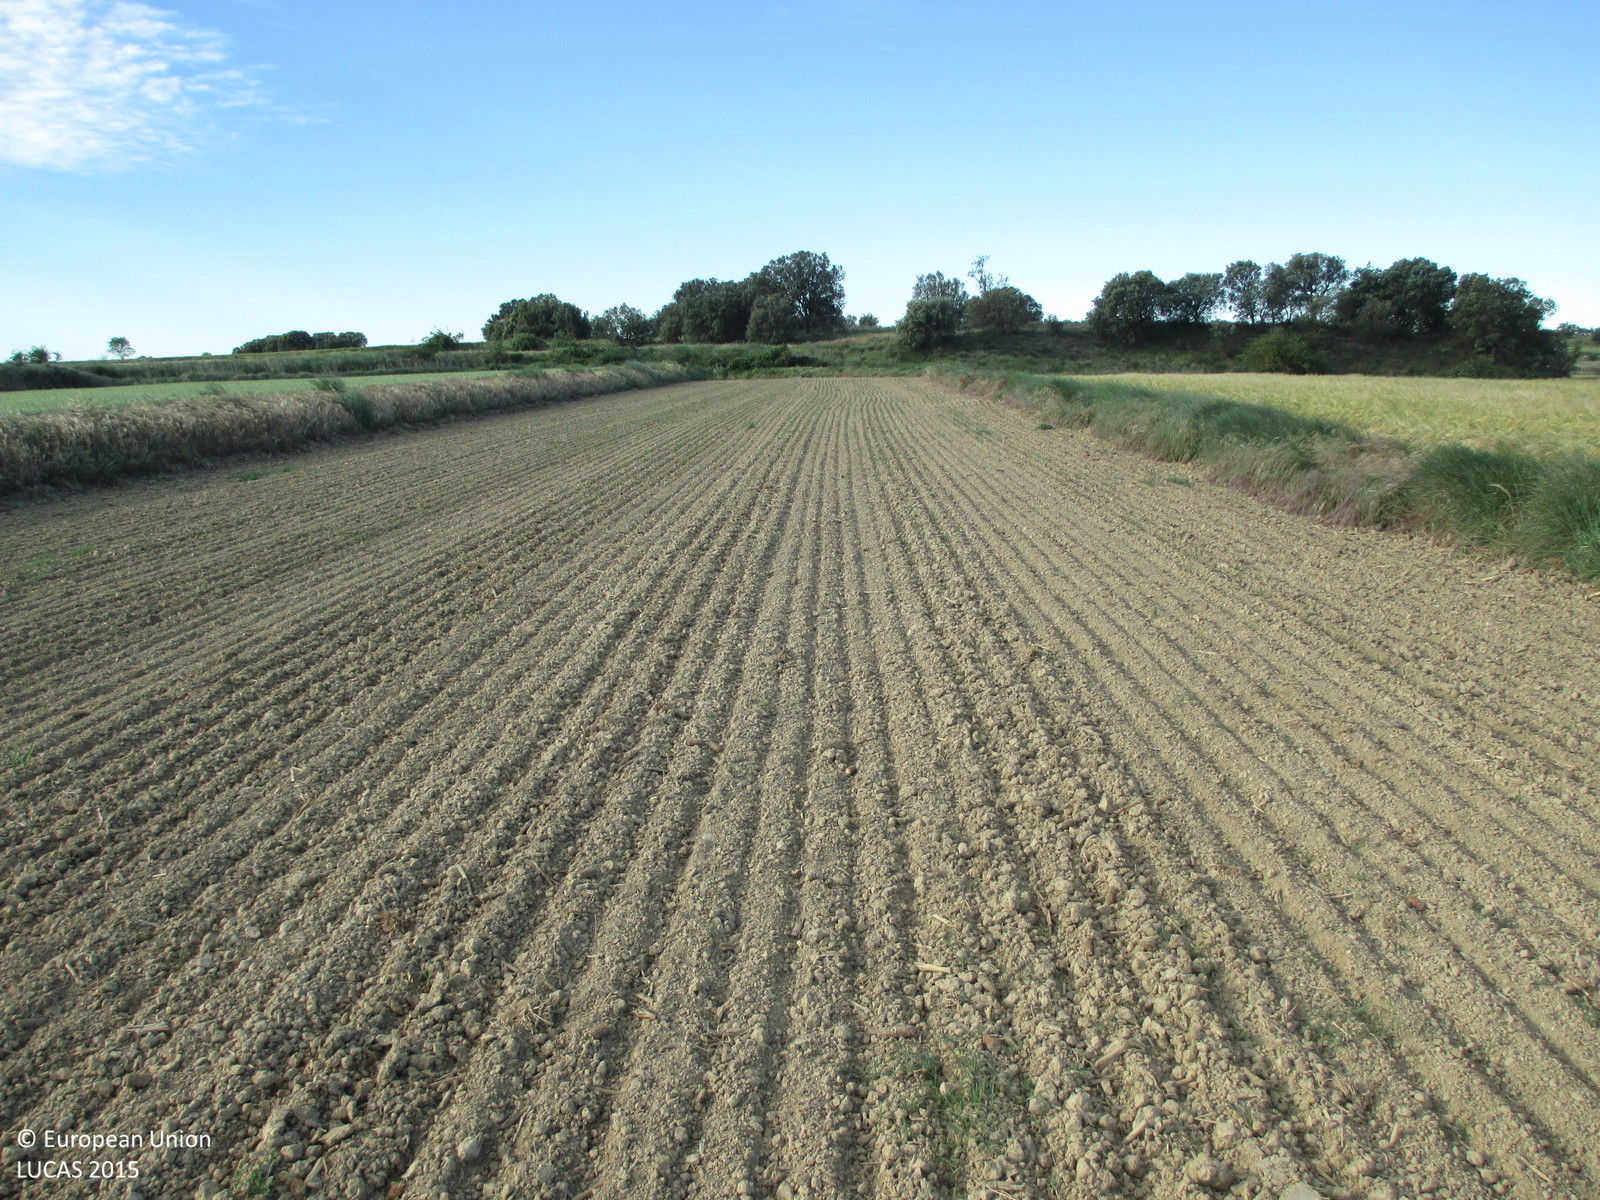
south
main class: Cropland
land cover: Maize
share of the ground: < 10 %
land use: Agriculture (excluding fallow land and kitchen gardens)
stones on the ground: < 10 %
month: May
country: ES
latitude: 42.0747
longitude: -0.2830
